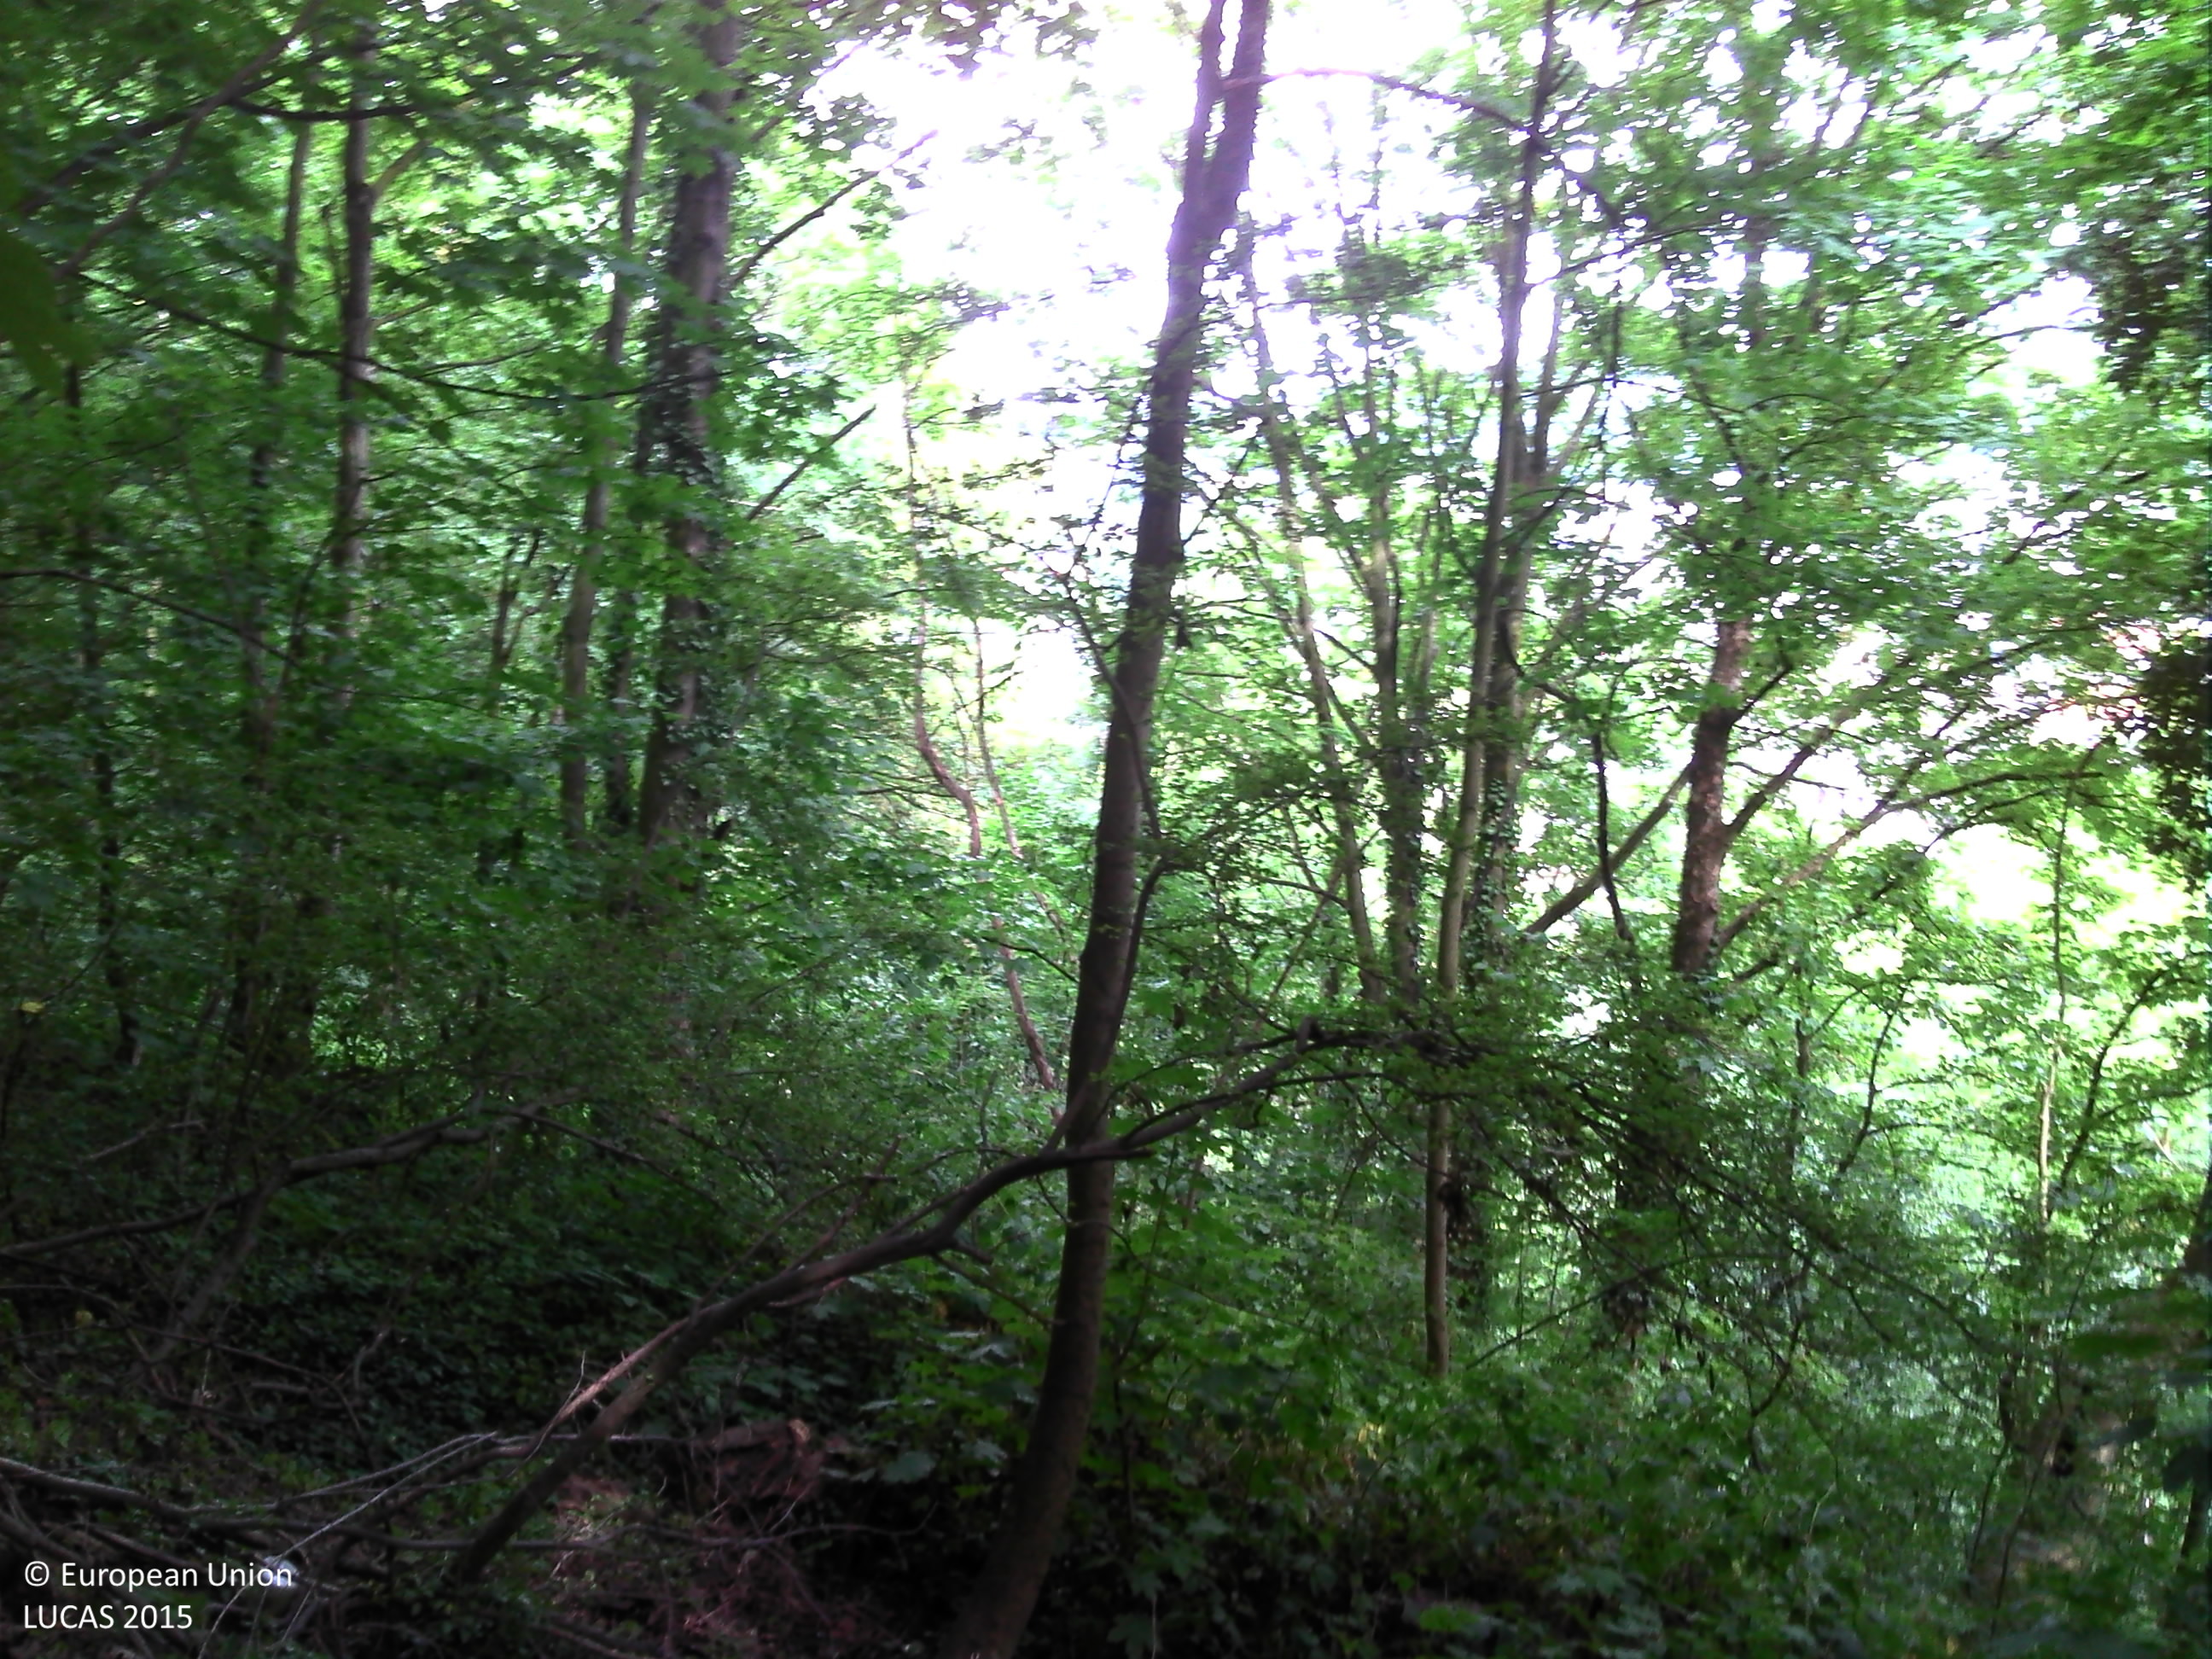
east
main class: Woodland
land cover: Broadleaved woodland
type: mesophytic deciduous forest
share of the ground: > 75 %
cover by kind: broadleaved forest trees 80 %, herbaceous plants 20 %
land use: Forestry
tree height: > 5 m
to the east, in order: Broadleaved woodland; Rock outcrops; Tracks; Broadleaved woodland; Tracks; Grass margins; Dry stone walls; Inland fresh running water; Abandoned hedges; Artificial constructions in urban areas
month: July
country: BE
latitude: 50.5952
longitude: 5.8596
